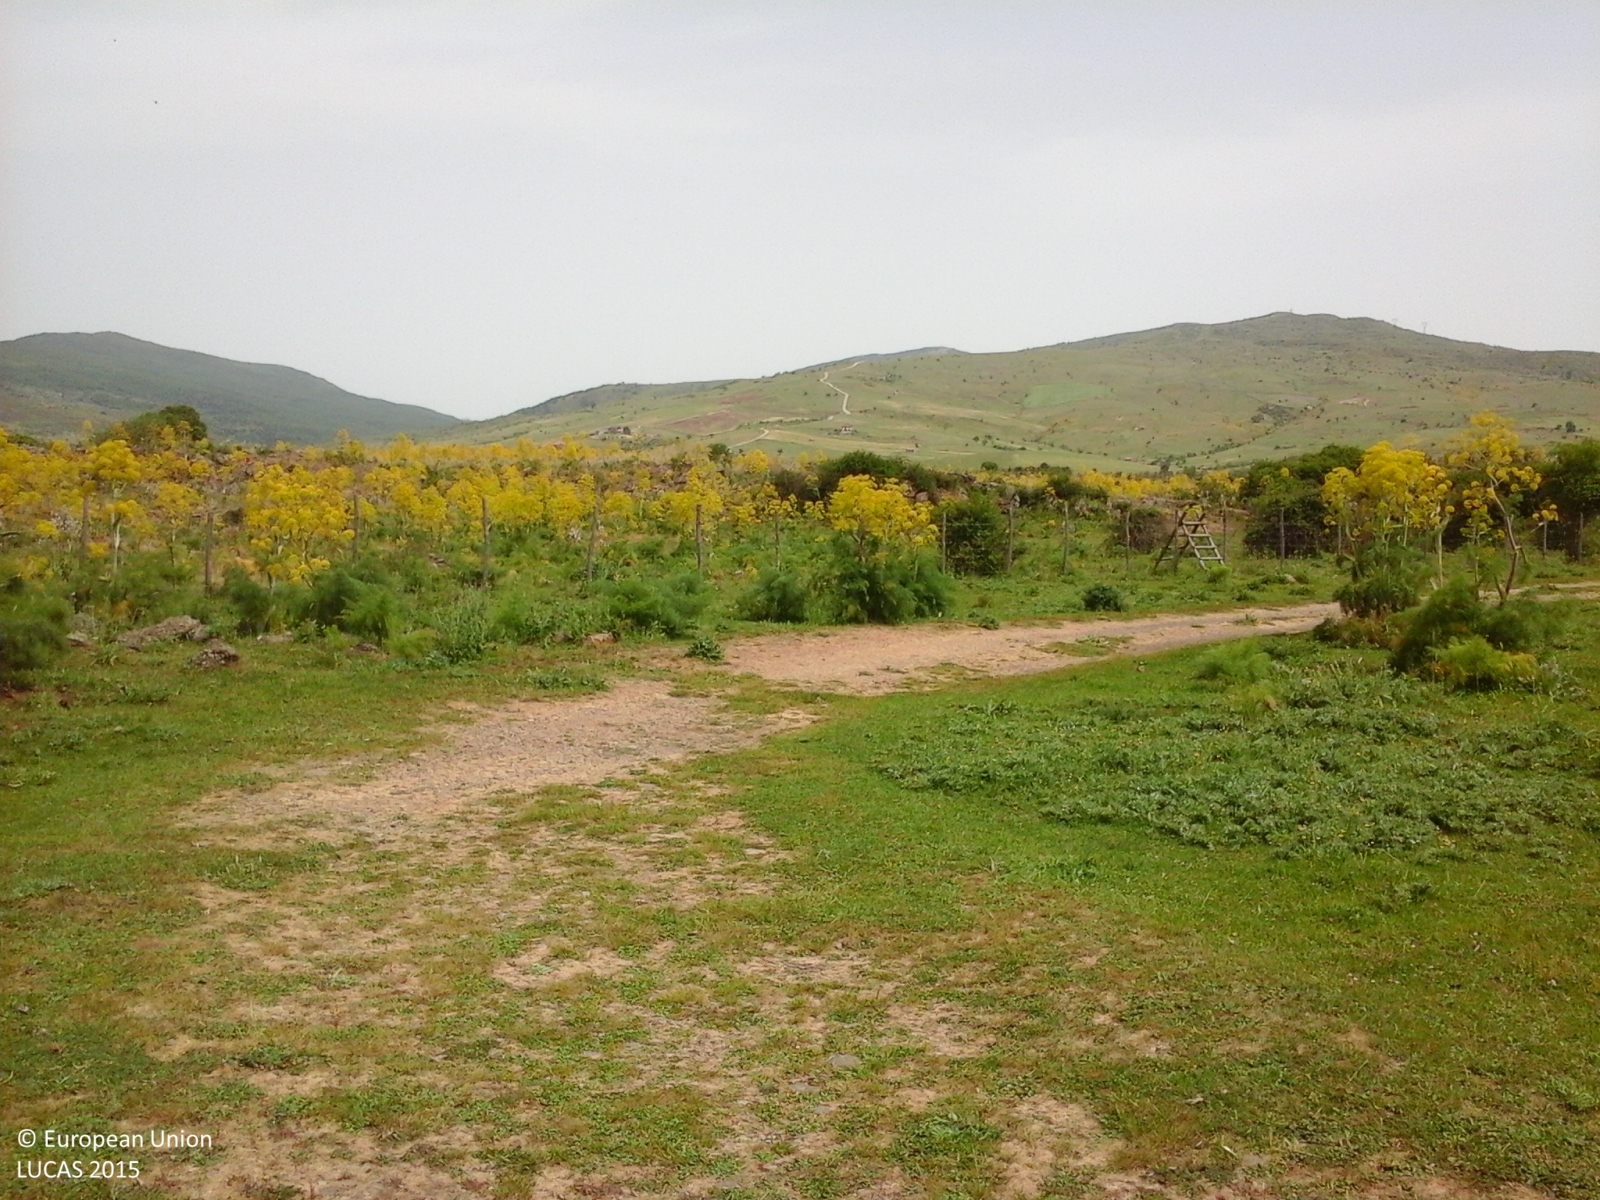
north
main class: Grassland
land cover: Grassland without tree/shrub cover
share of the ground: > 75 %
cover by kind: herbaceous plants 100 %
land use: Agriculture (excluding fallow land and kitchen gardens)
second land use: Amenities, museums, leisure
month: May
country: IT
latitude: 37.8581
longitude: 14.8880
